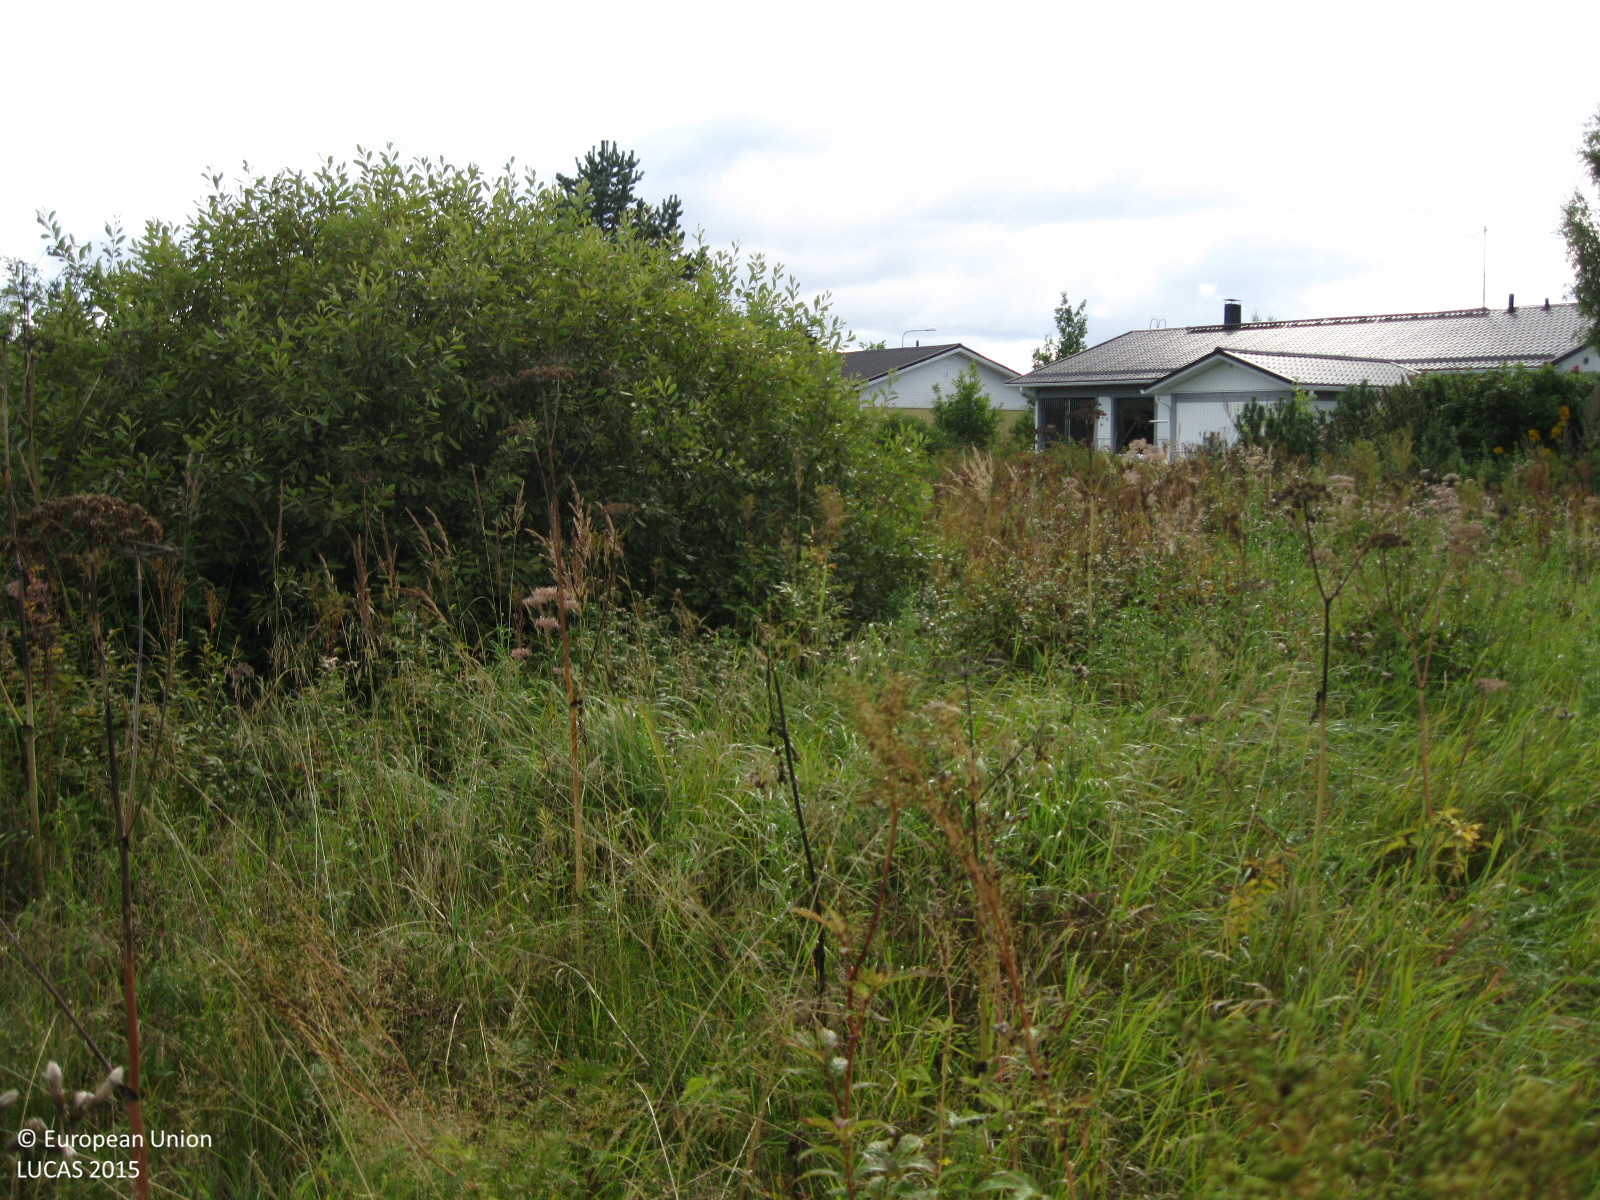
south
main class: Grassland
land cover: Grassland with sparse tree/shrub cover
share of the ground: > 75 %
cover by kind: herbaceous plants 95 %, broadleaved forest trees 5 %
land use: Residential
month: September
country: FI
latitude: 60.4741
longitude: 24.8303
